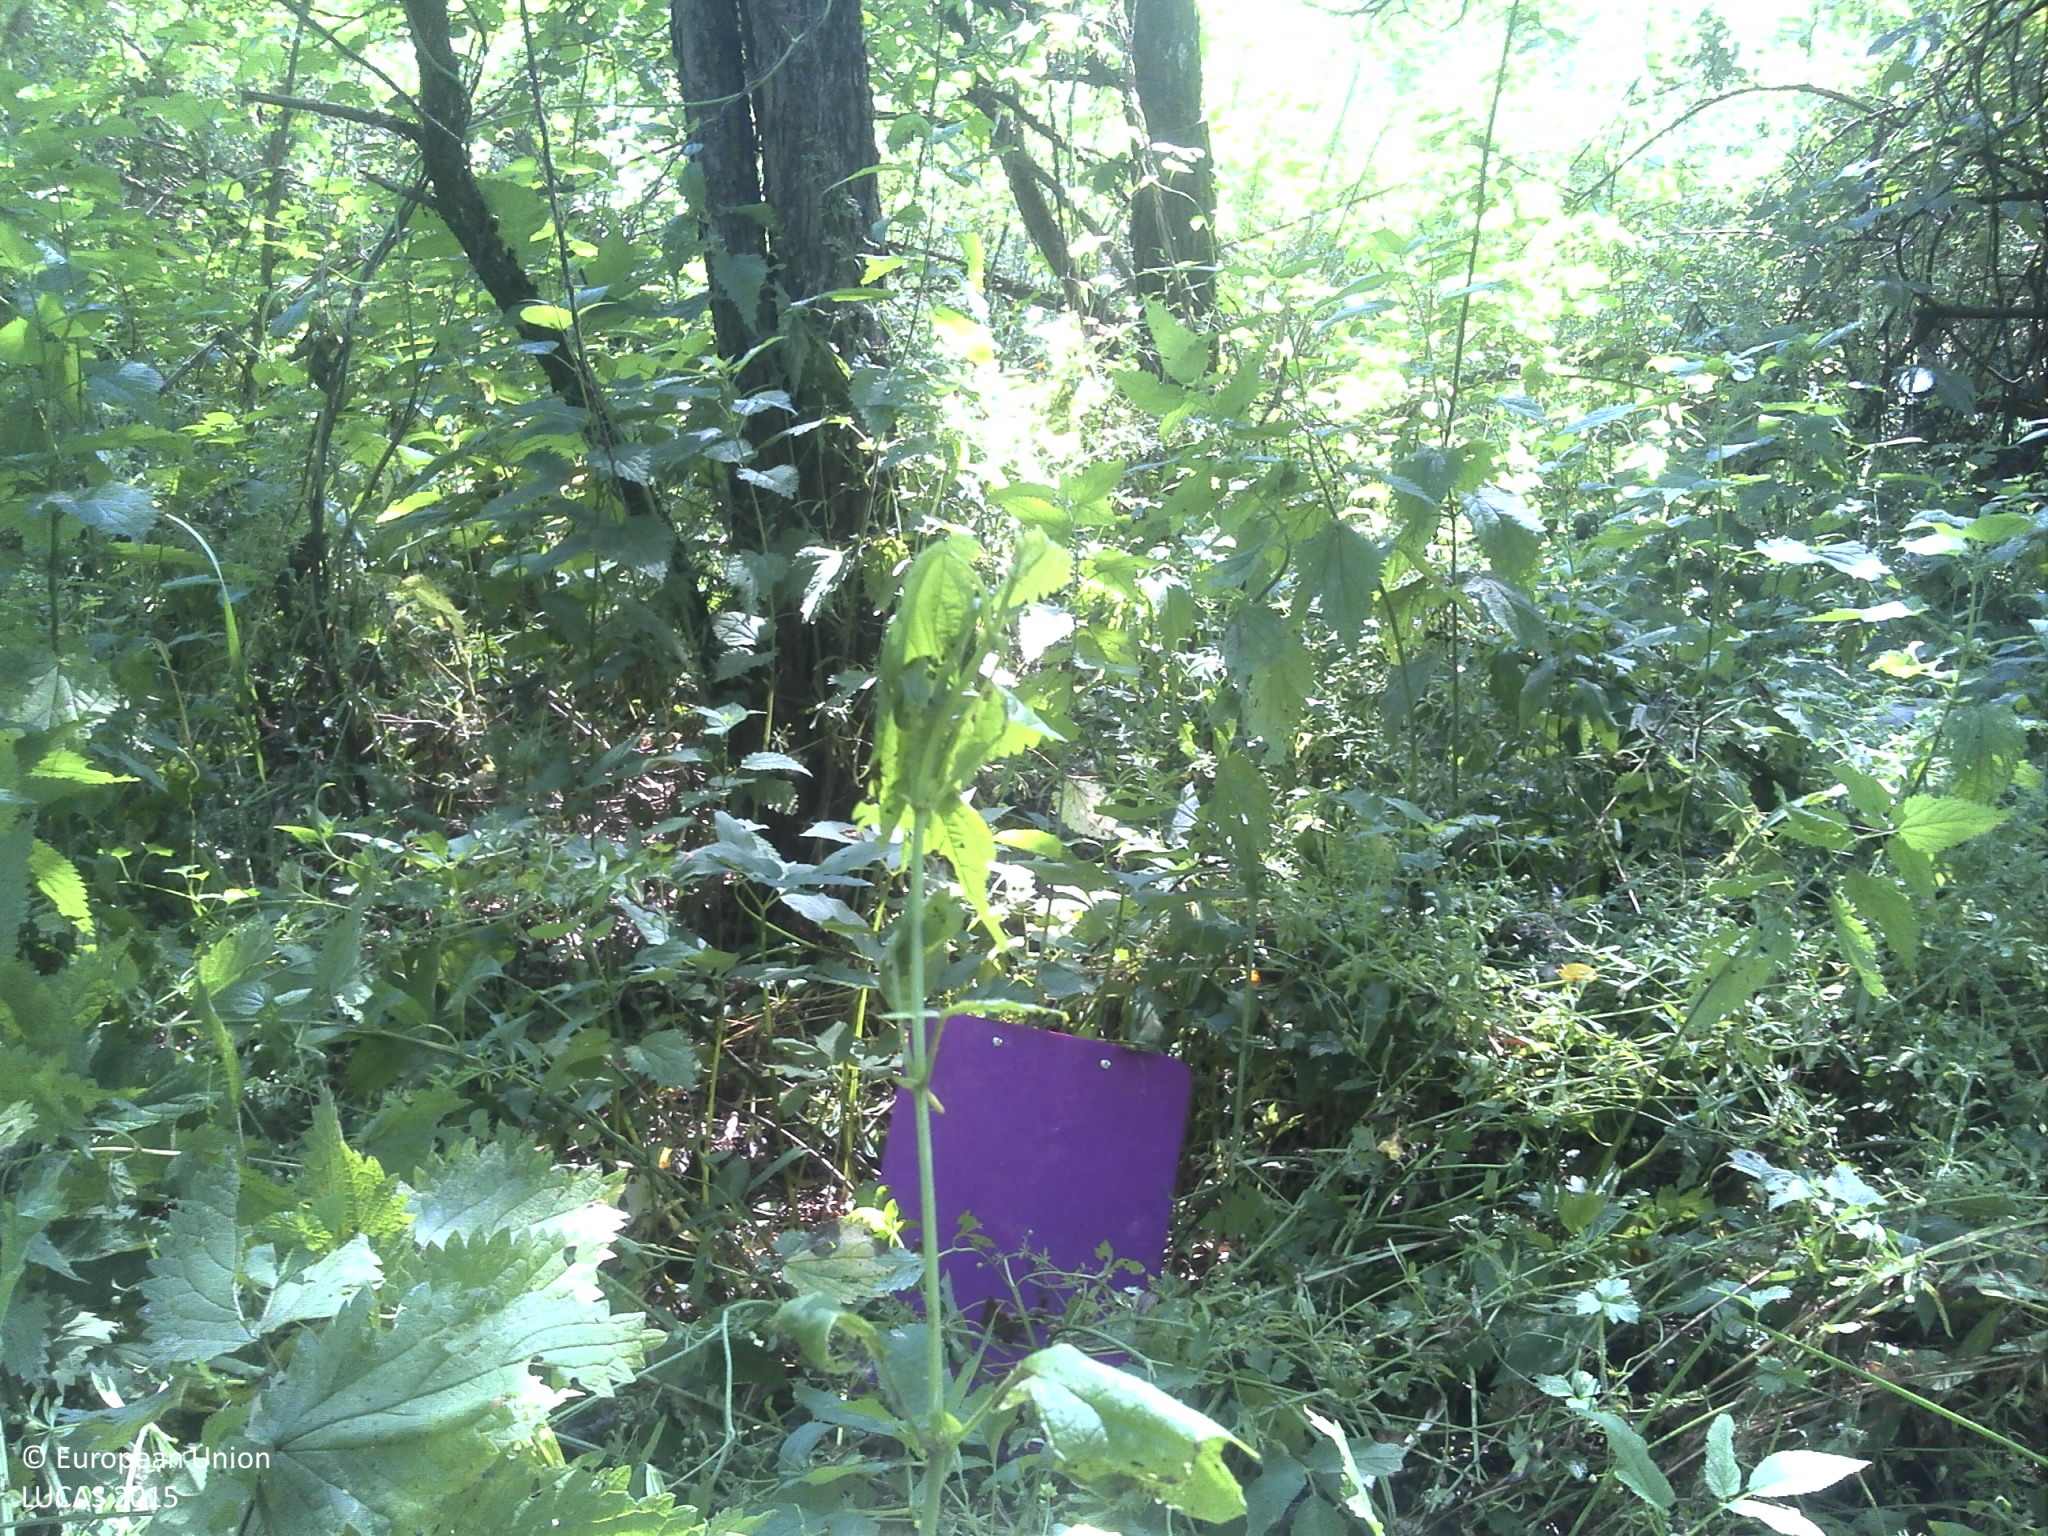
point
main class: Shrubland
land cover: Shrubland with sparse tree cover
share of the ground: > 75 %
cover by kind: shrubs 75 %, herbaceous plants 15 %, broadleaved forest trees 5 %, lichens and mosses 5 %
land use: Forestry
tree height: > 5 m
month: June
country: HR
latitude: 45.5647
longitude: 17.7285
